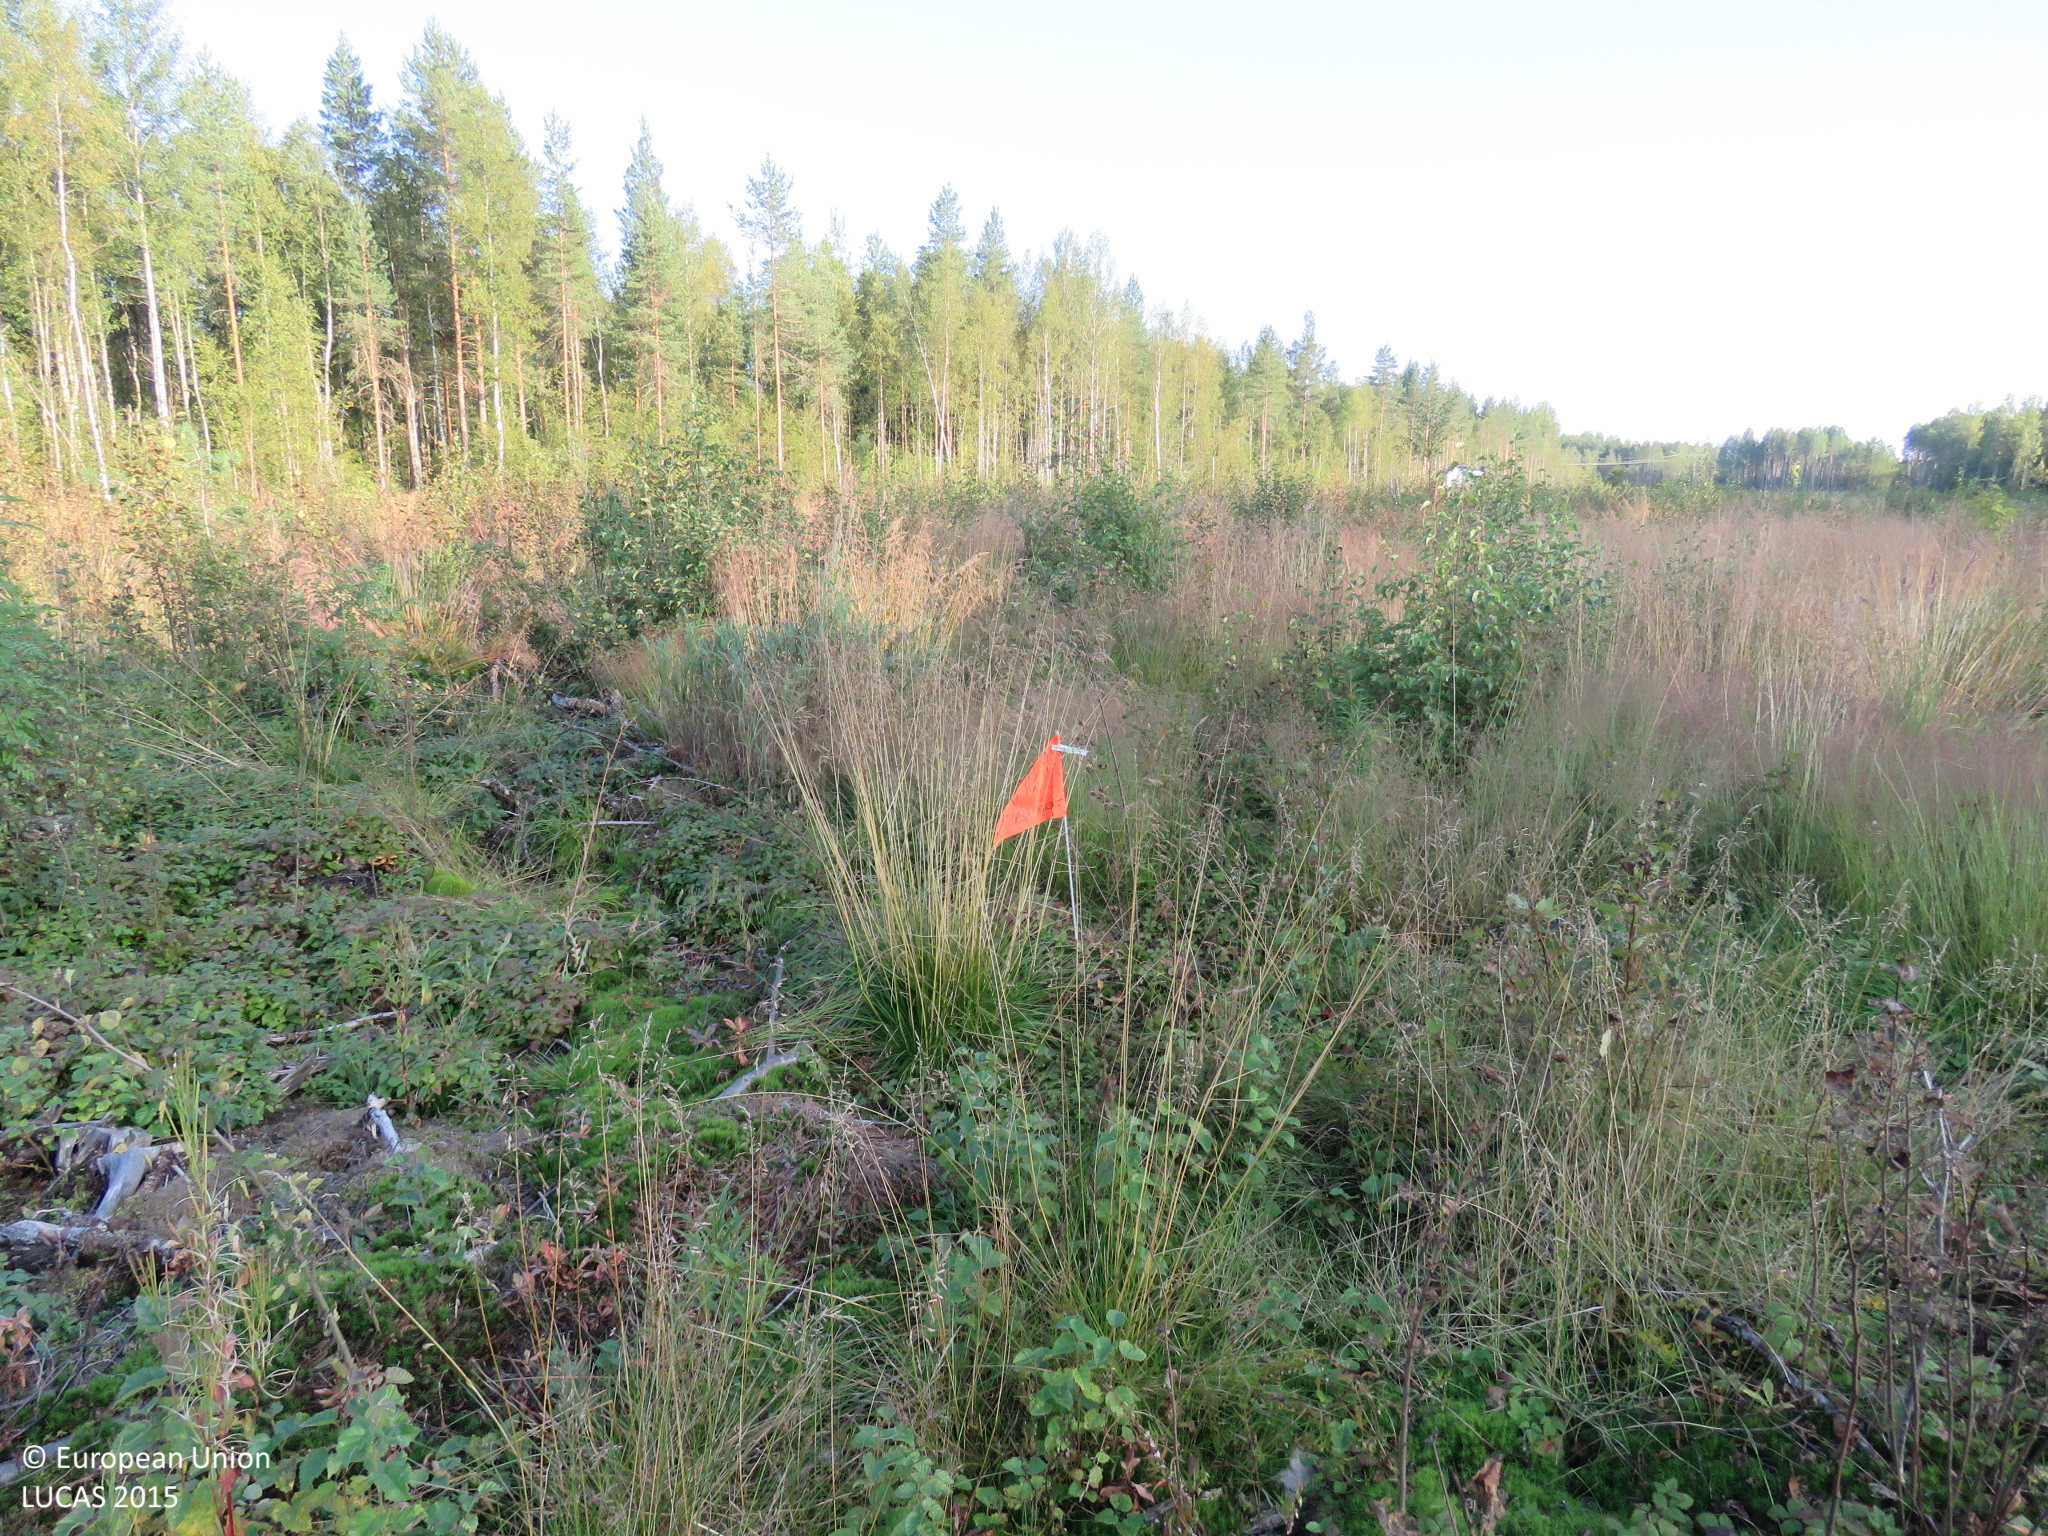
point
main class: Woodland
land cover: Broadleaved woodland
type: non-riverine alder, birch or aspen forest
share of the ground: 50 - 75 %
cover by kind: broadleaved forest trees 60 %, herbaceous plants 30 %, lichens and mosses 10 %
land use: Forestry
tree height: < 5 m
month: August
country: FI
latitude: 64.8756
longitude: 25.4297
